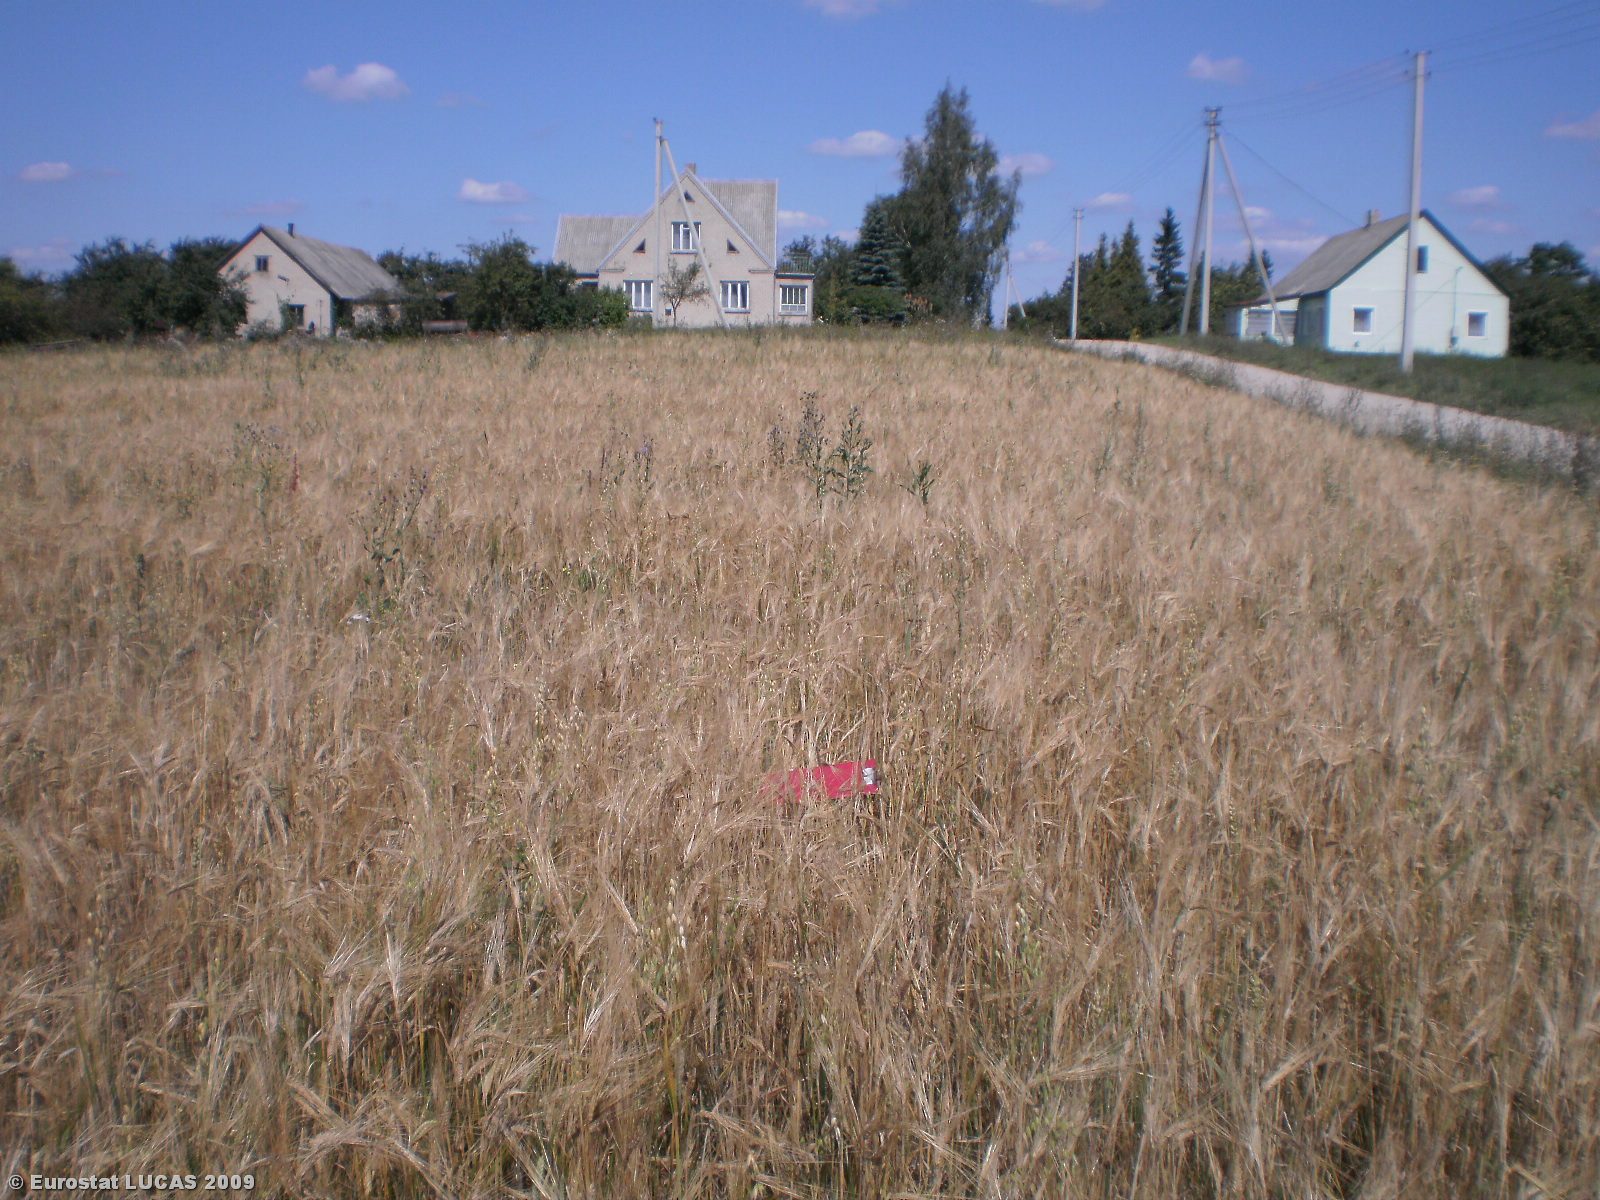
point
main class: Cropland
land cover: Barley
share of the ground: > 75 %
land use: Agriculture (excluding fallow land and kitchen gardens)
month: August
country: LT
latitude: 55.7032
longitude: 24.9893
